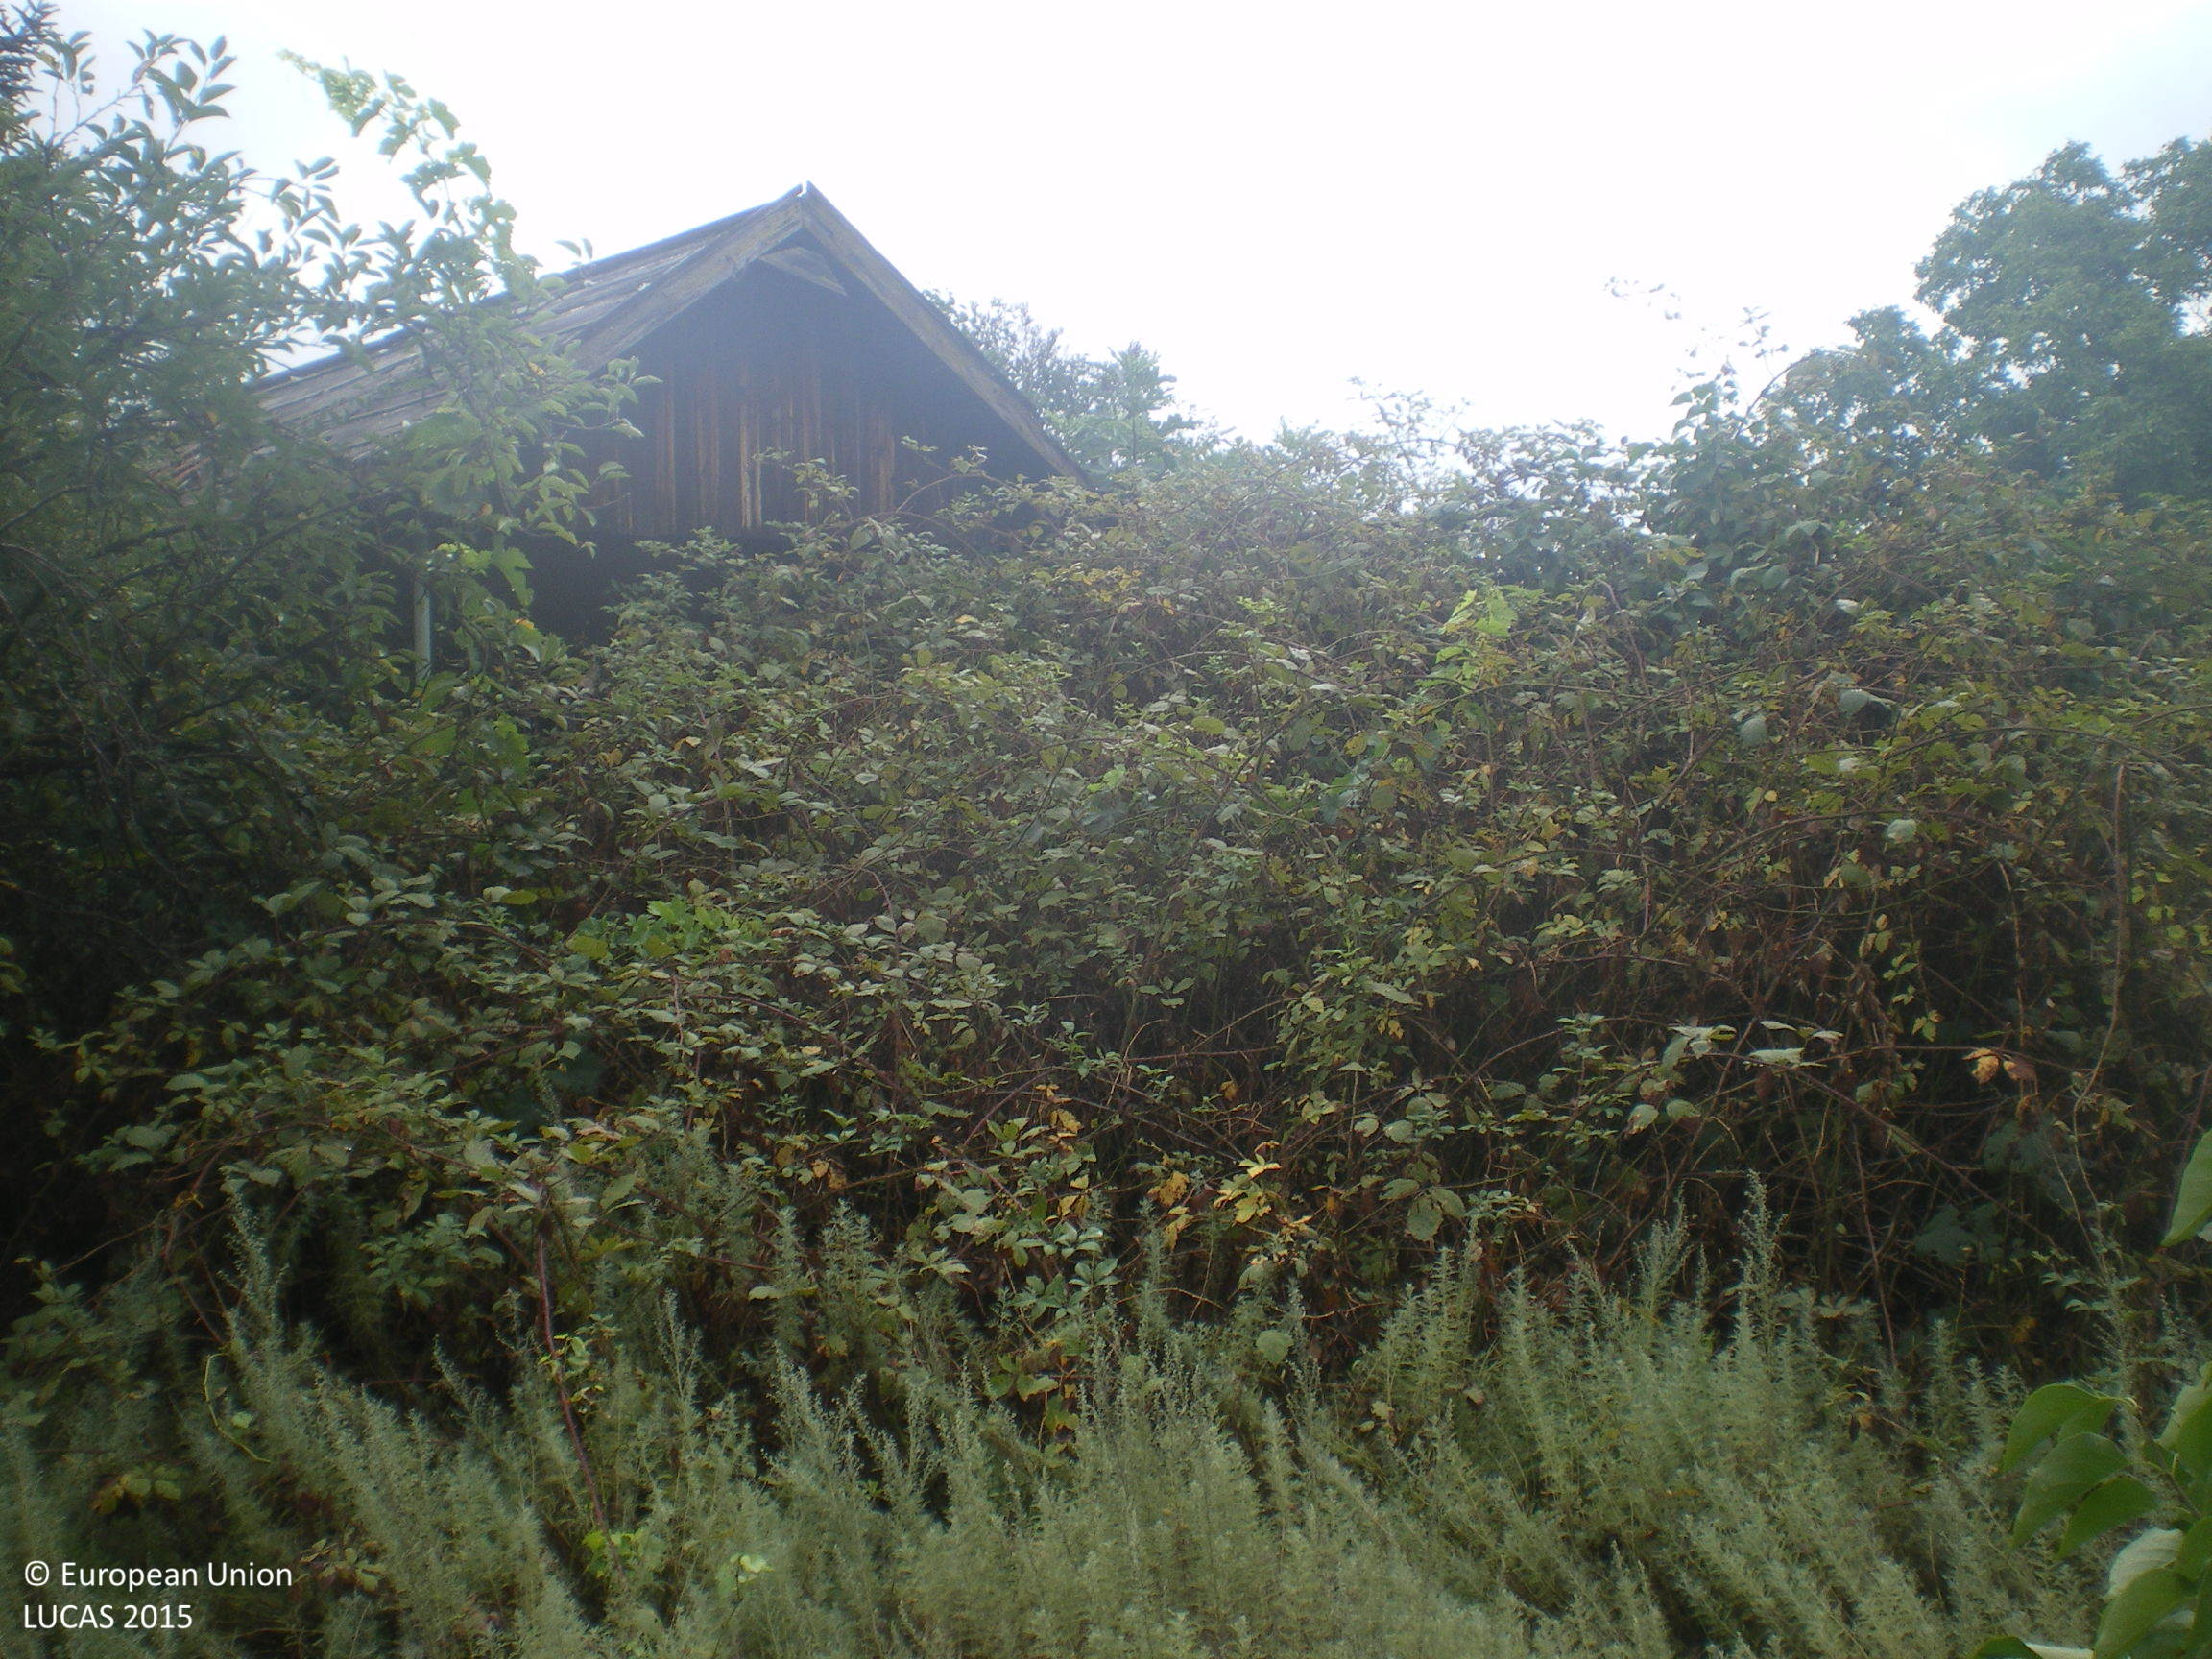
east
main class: Shrubland
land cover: Shrubland with sparse tree cover
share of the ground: 50 - 75 %
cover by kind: shrubs 55 %, herbaceous plants 40 %, broadleaved forest trees 5 %
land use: Fallow land
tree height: > 5 m
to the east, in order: Shrubland with sparse tree cover; Artificial constructions in urban areas; Broadleaved woodland; Shrubland without tree cover; Tracks; Grassland with sparse tree/shrub cover; Vineyards; Broadleaved woodland; Tracks; Shrubland with sparse tree cover; Grassland with sparse tree/shrub cover
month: August
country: BG
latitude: 42.3022
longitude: 25.9312
